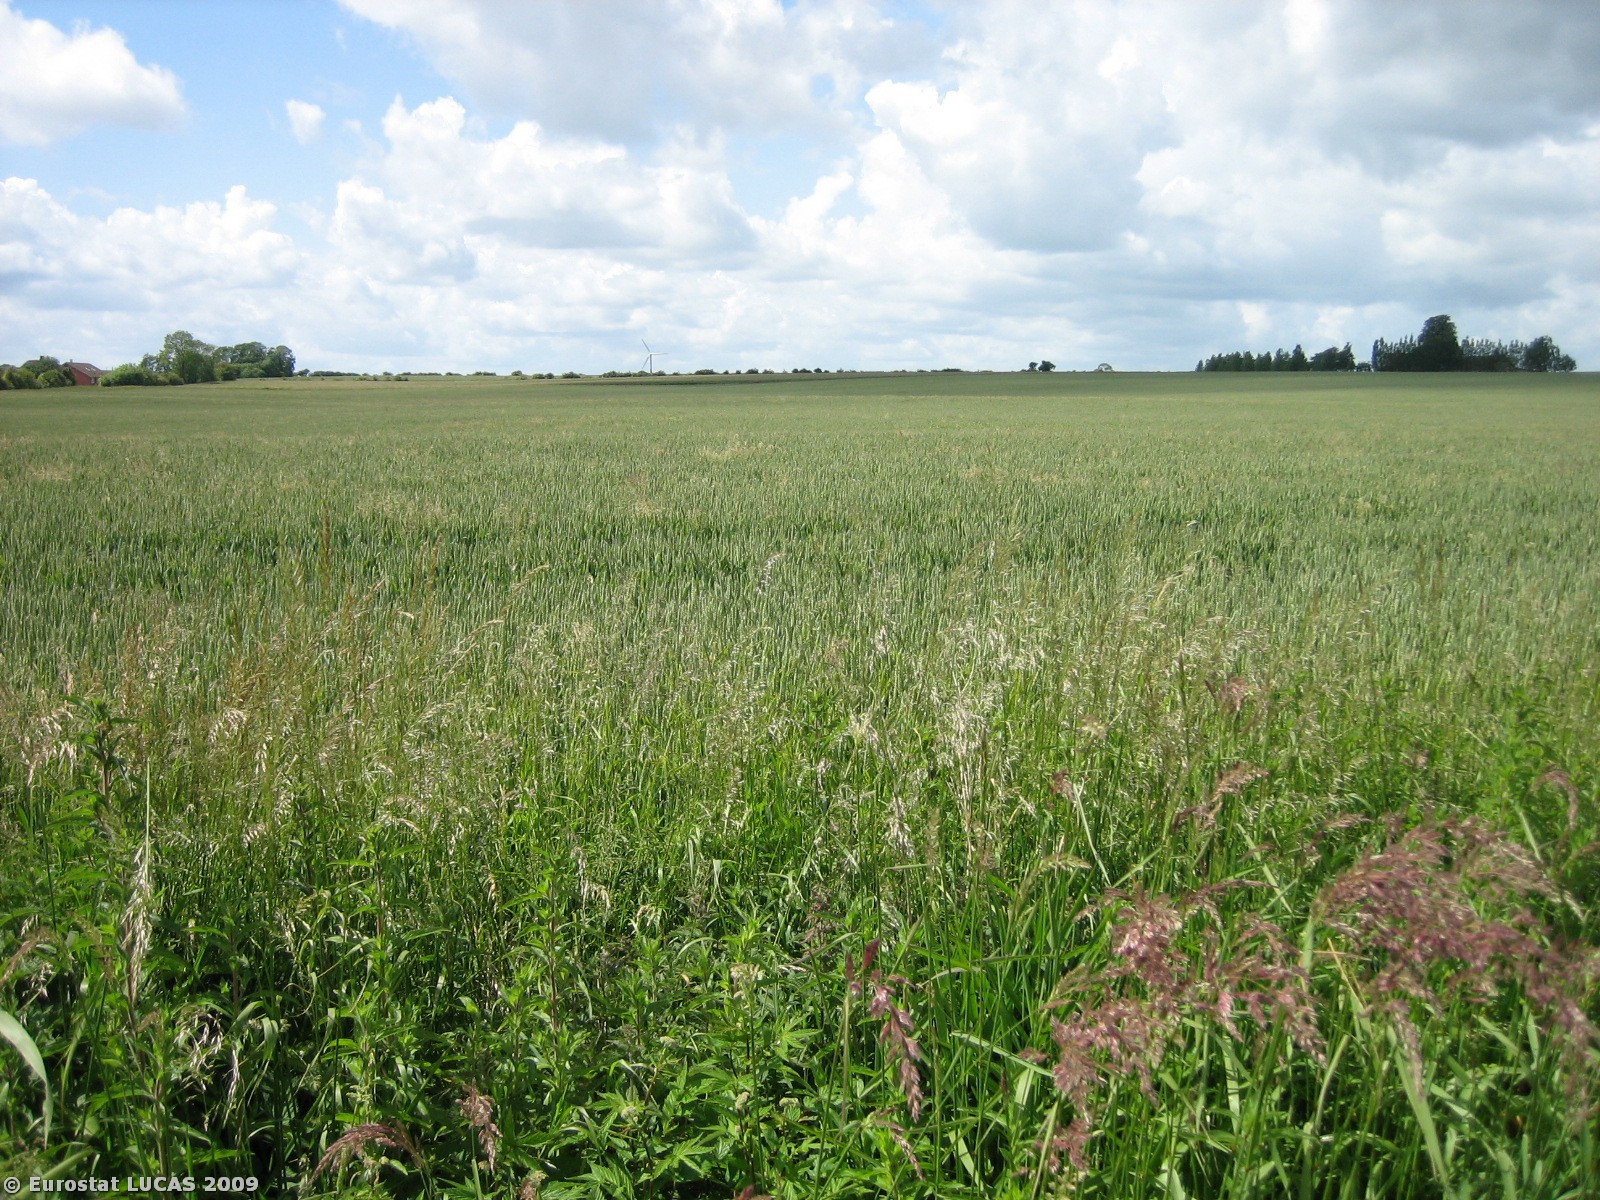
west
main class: Cropland
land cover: Common wheat
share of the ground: > 75 %
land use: Agriculture (excluding fallow land and kitchen gardens)
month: June
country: DK
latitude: 55.6124
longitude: 9.7938
